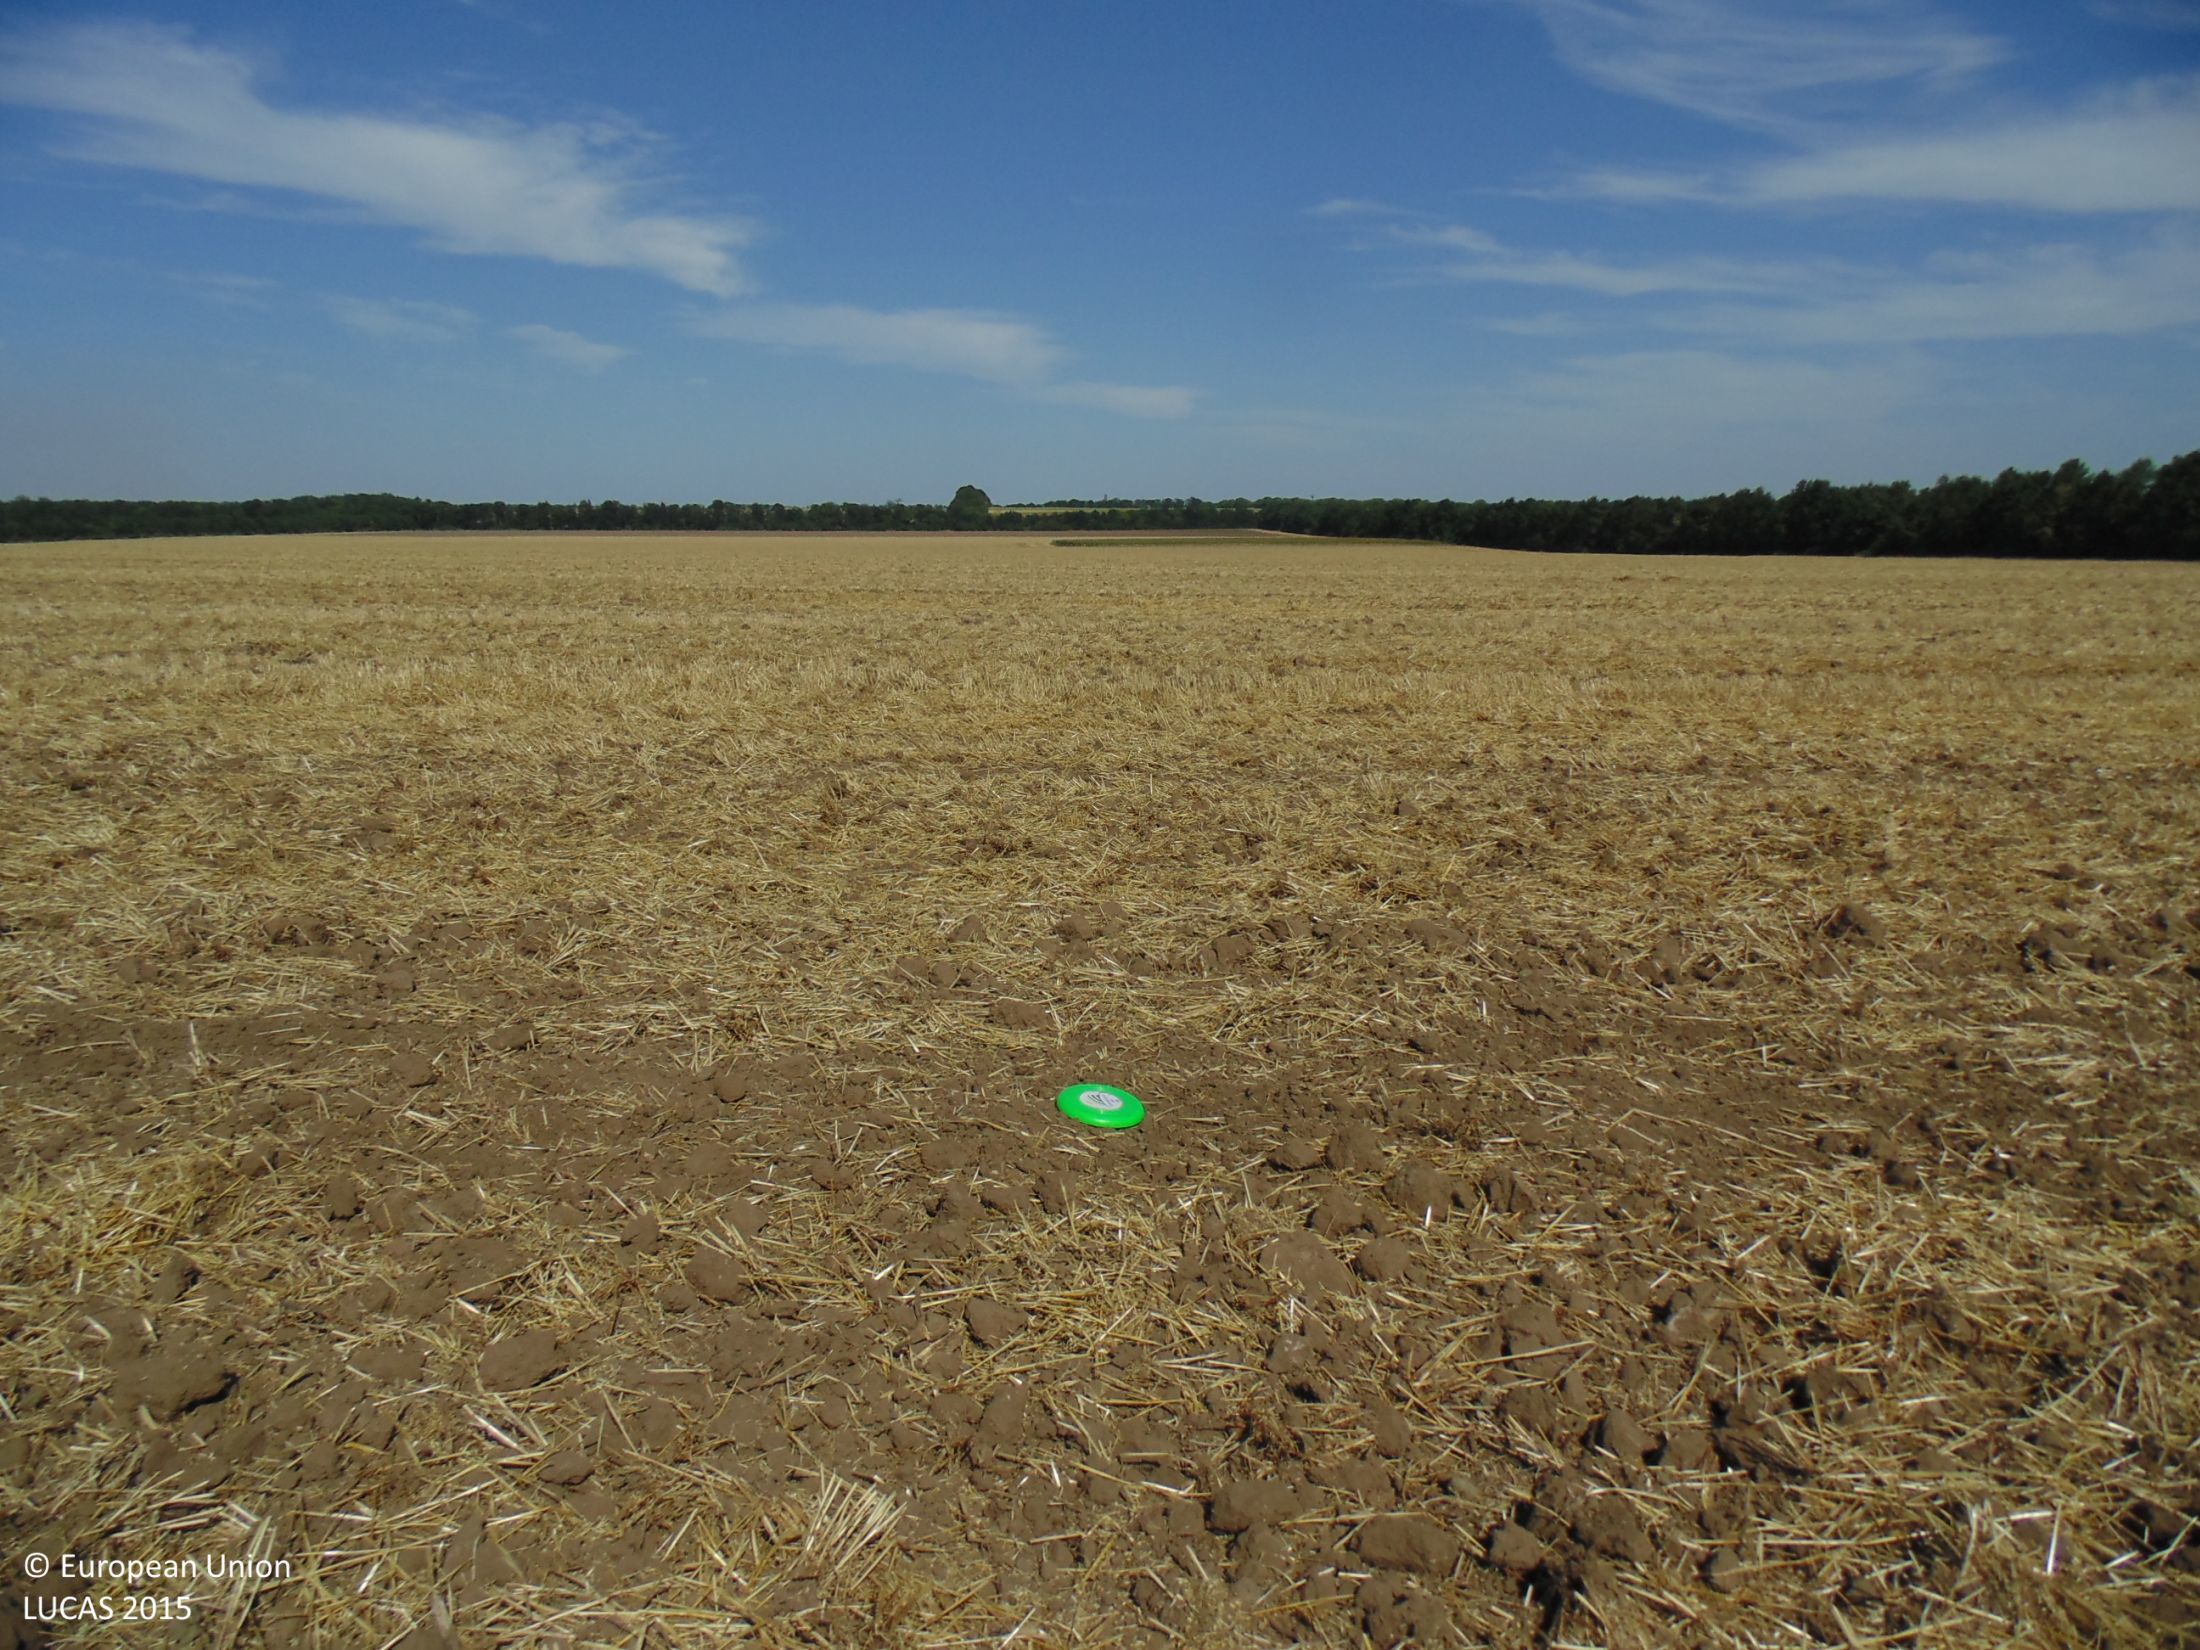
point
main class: Cropland
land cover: Common wheat
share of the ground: < 10 %
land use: Agriculture (excluding fallow land and kitchen gardens)
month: August
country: BG
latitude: 43.8084
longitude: 27.7057
